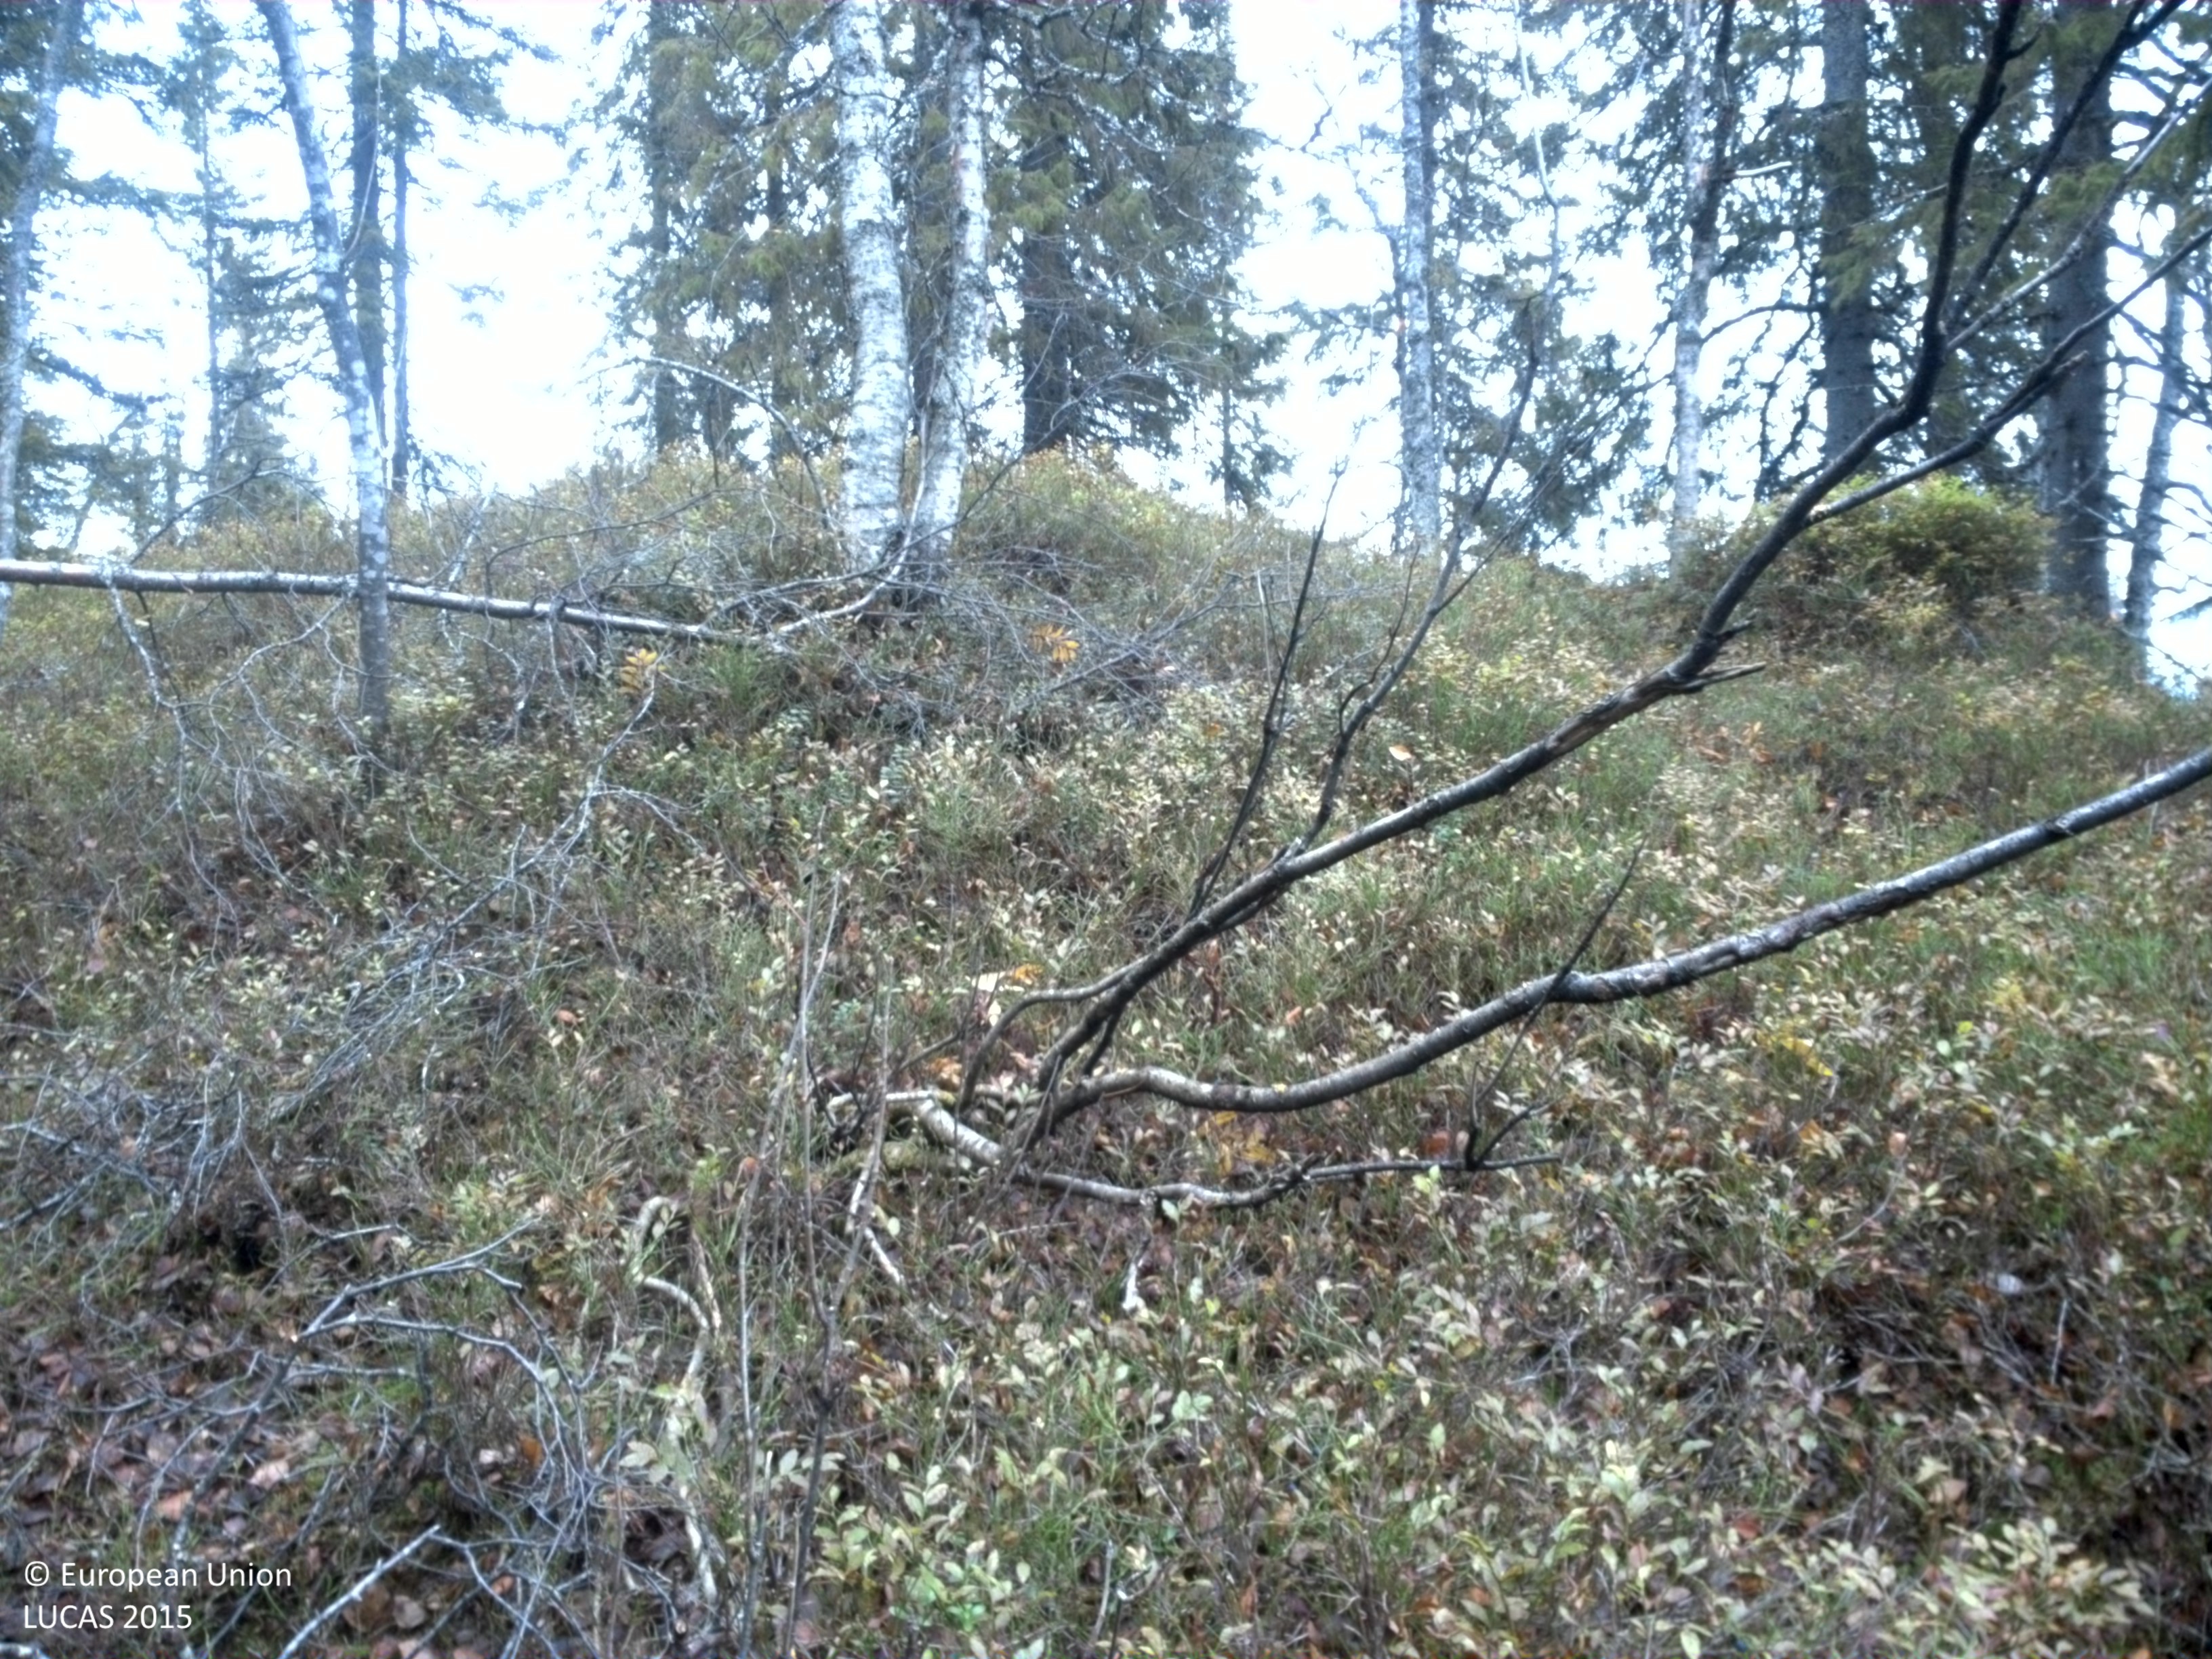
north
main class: Woodland
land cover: Spruce dominated mixed woodland
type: boreal forest
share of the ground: 25 - 50 %
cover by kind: shrubs 45 %, coniferous forest trees 25 %, broadleaved forest trees 10 %, herbaceous plants 10 %, lichens and mosses 10 %
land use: Forestry
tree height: > 5 m
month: October
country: SE
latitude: 64.4866
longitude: 16.3979
